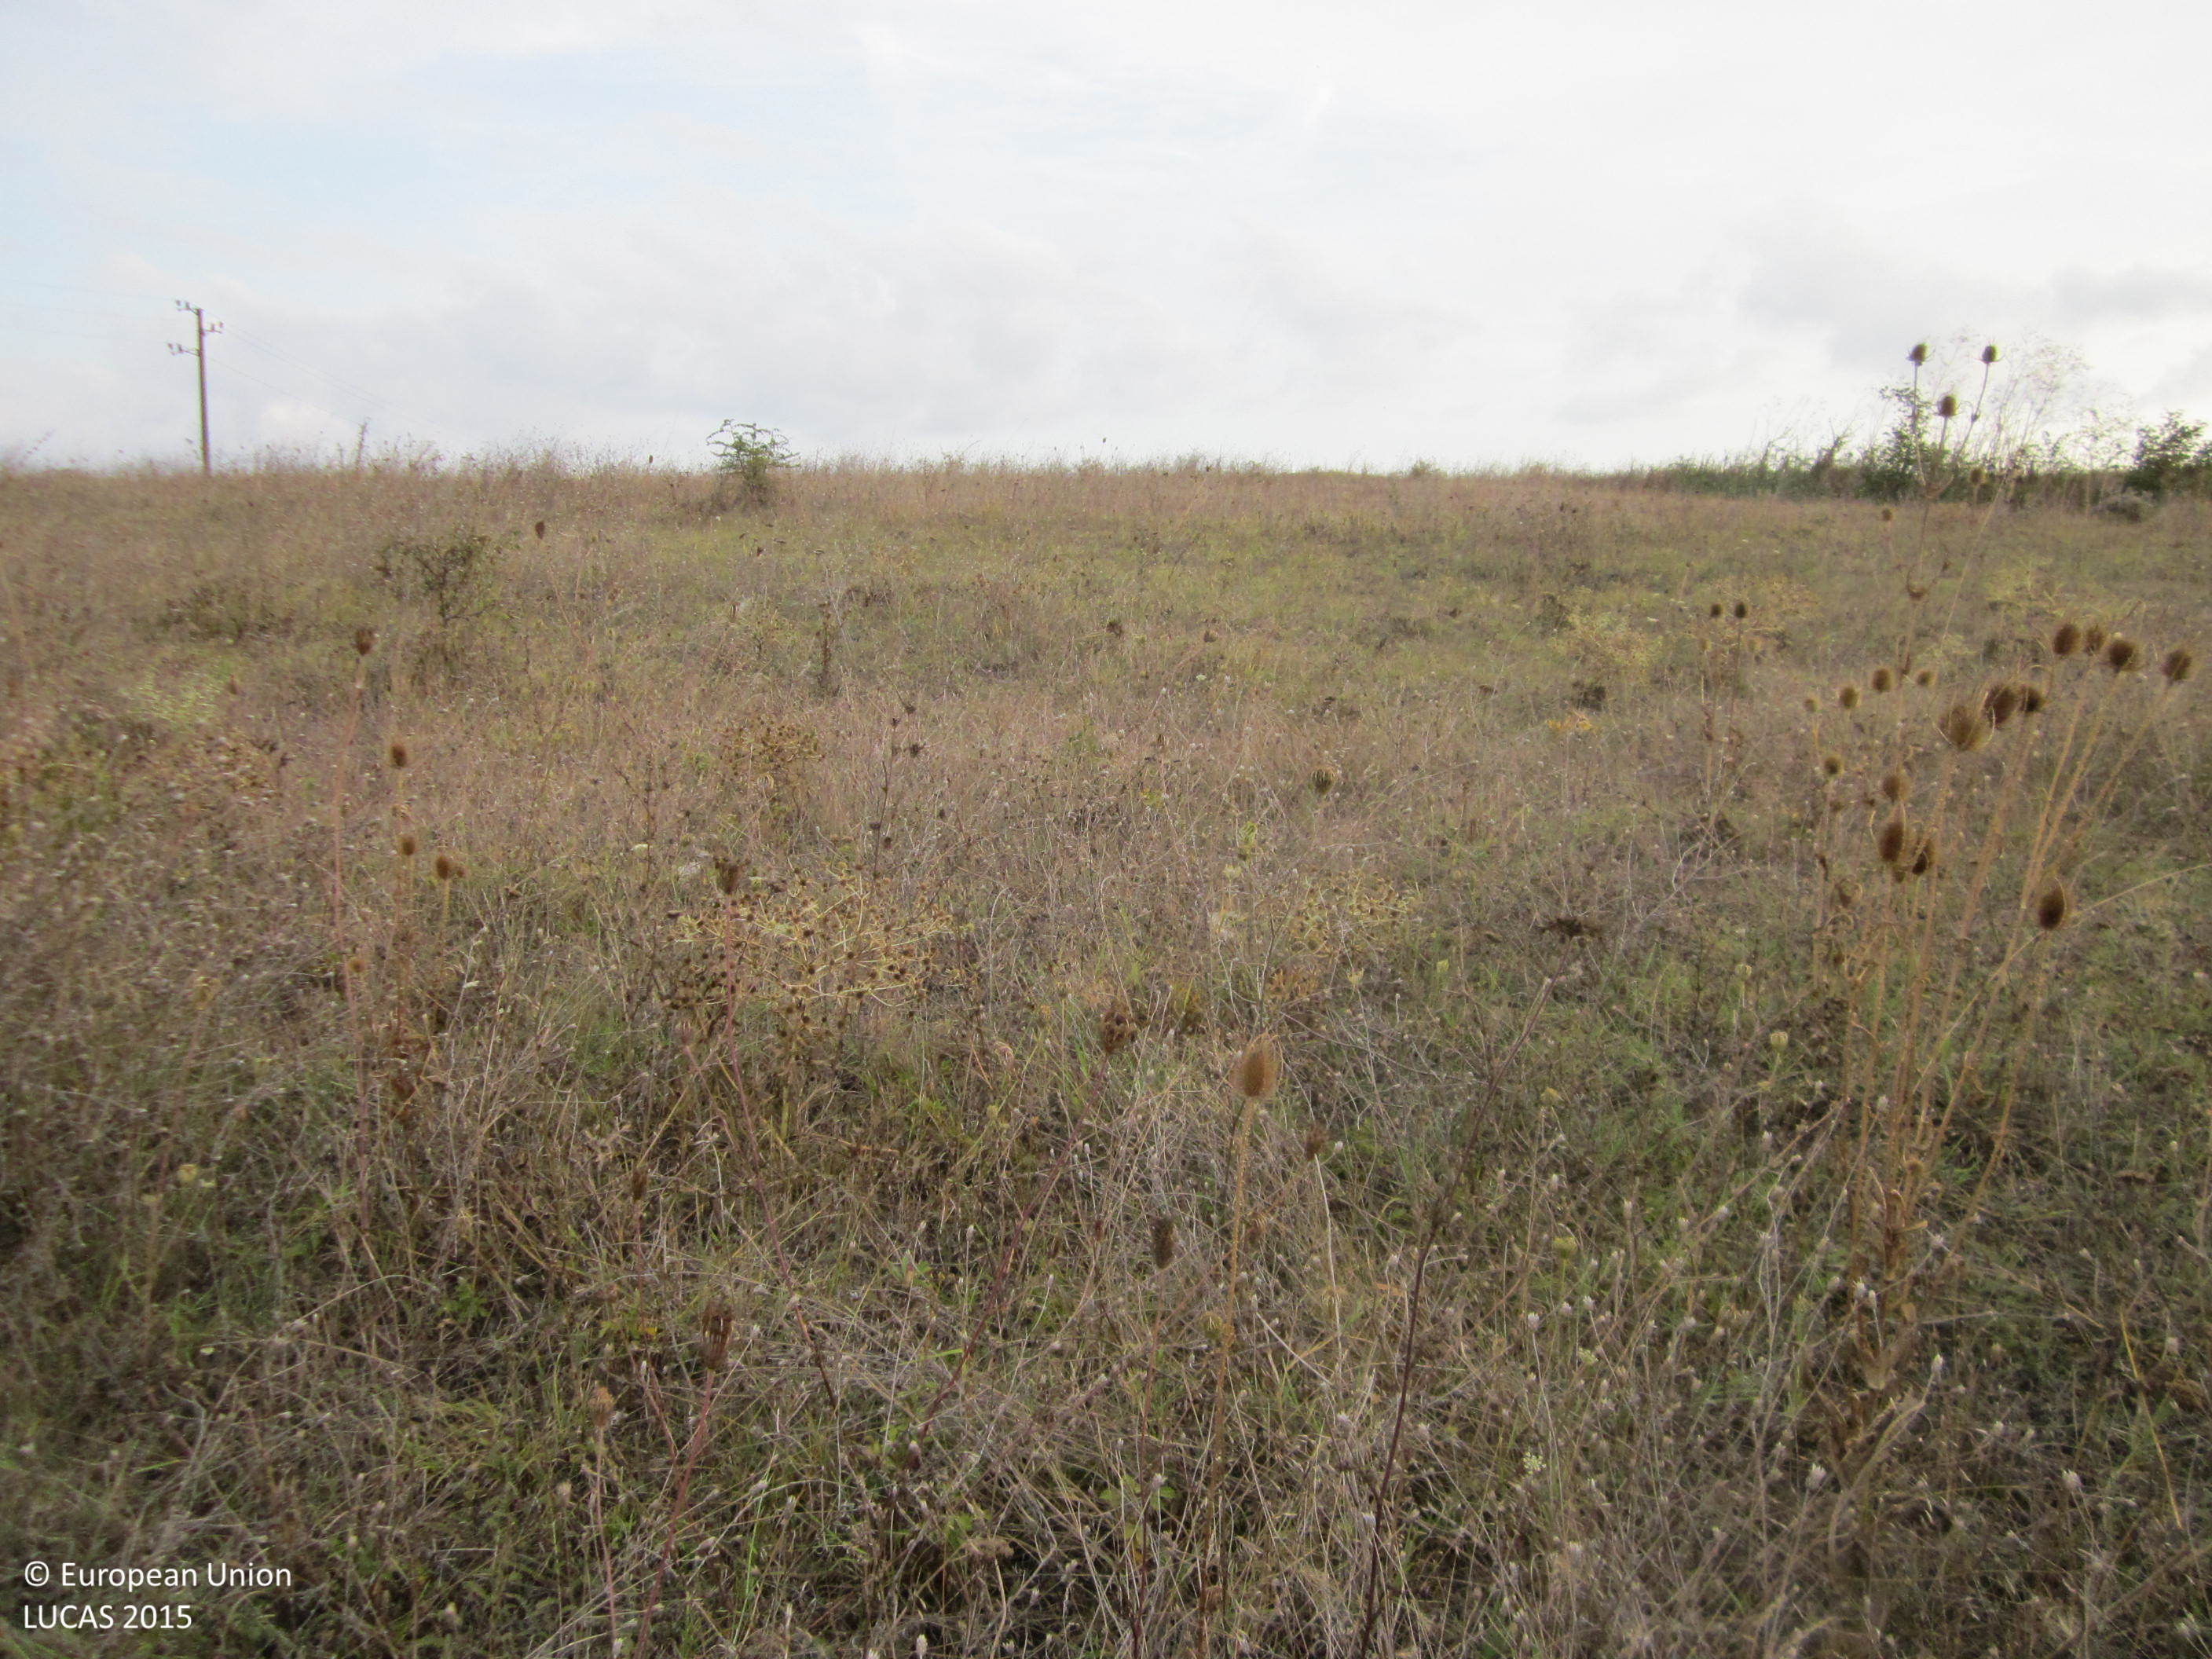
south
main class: Grassland
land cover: Grassland without tree/shrub cover
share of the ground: > 75 %
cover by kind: herbaceous plants 100 %
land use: Agriculture (excluding fallow land and kitchen gardens)
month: September
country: BG
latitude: 42.3899
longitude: 27.1745
